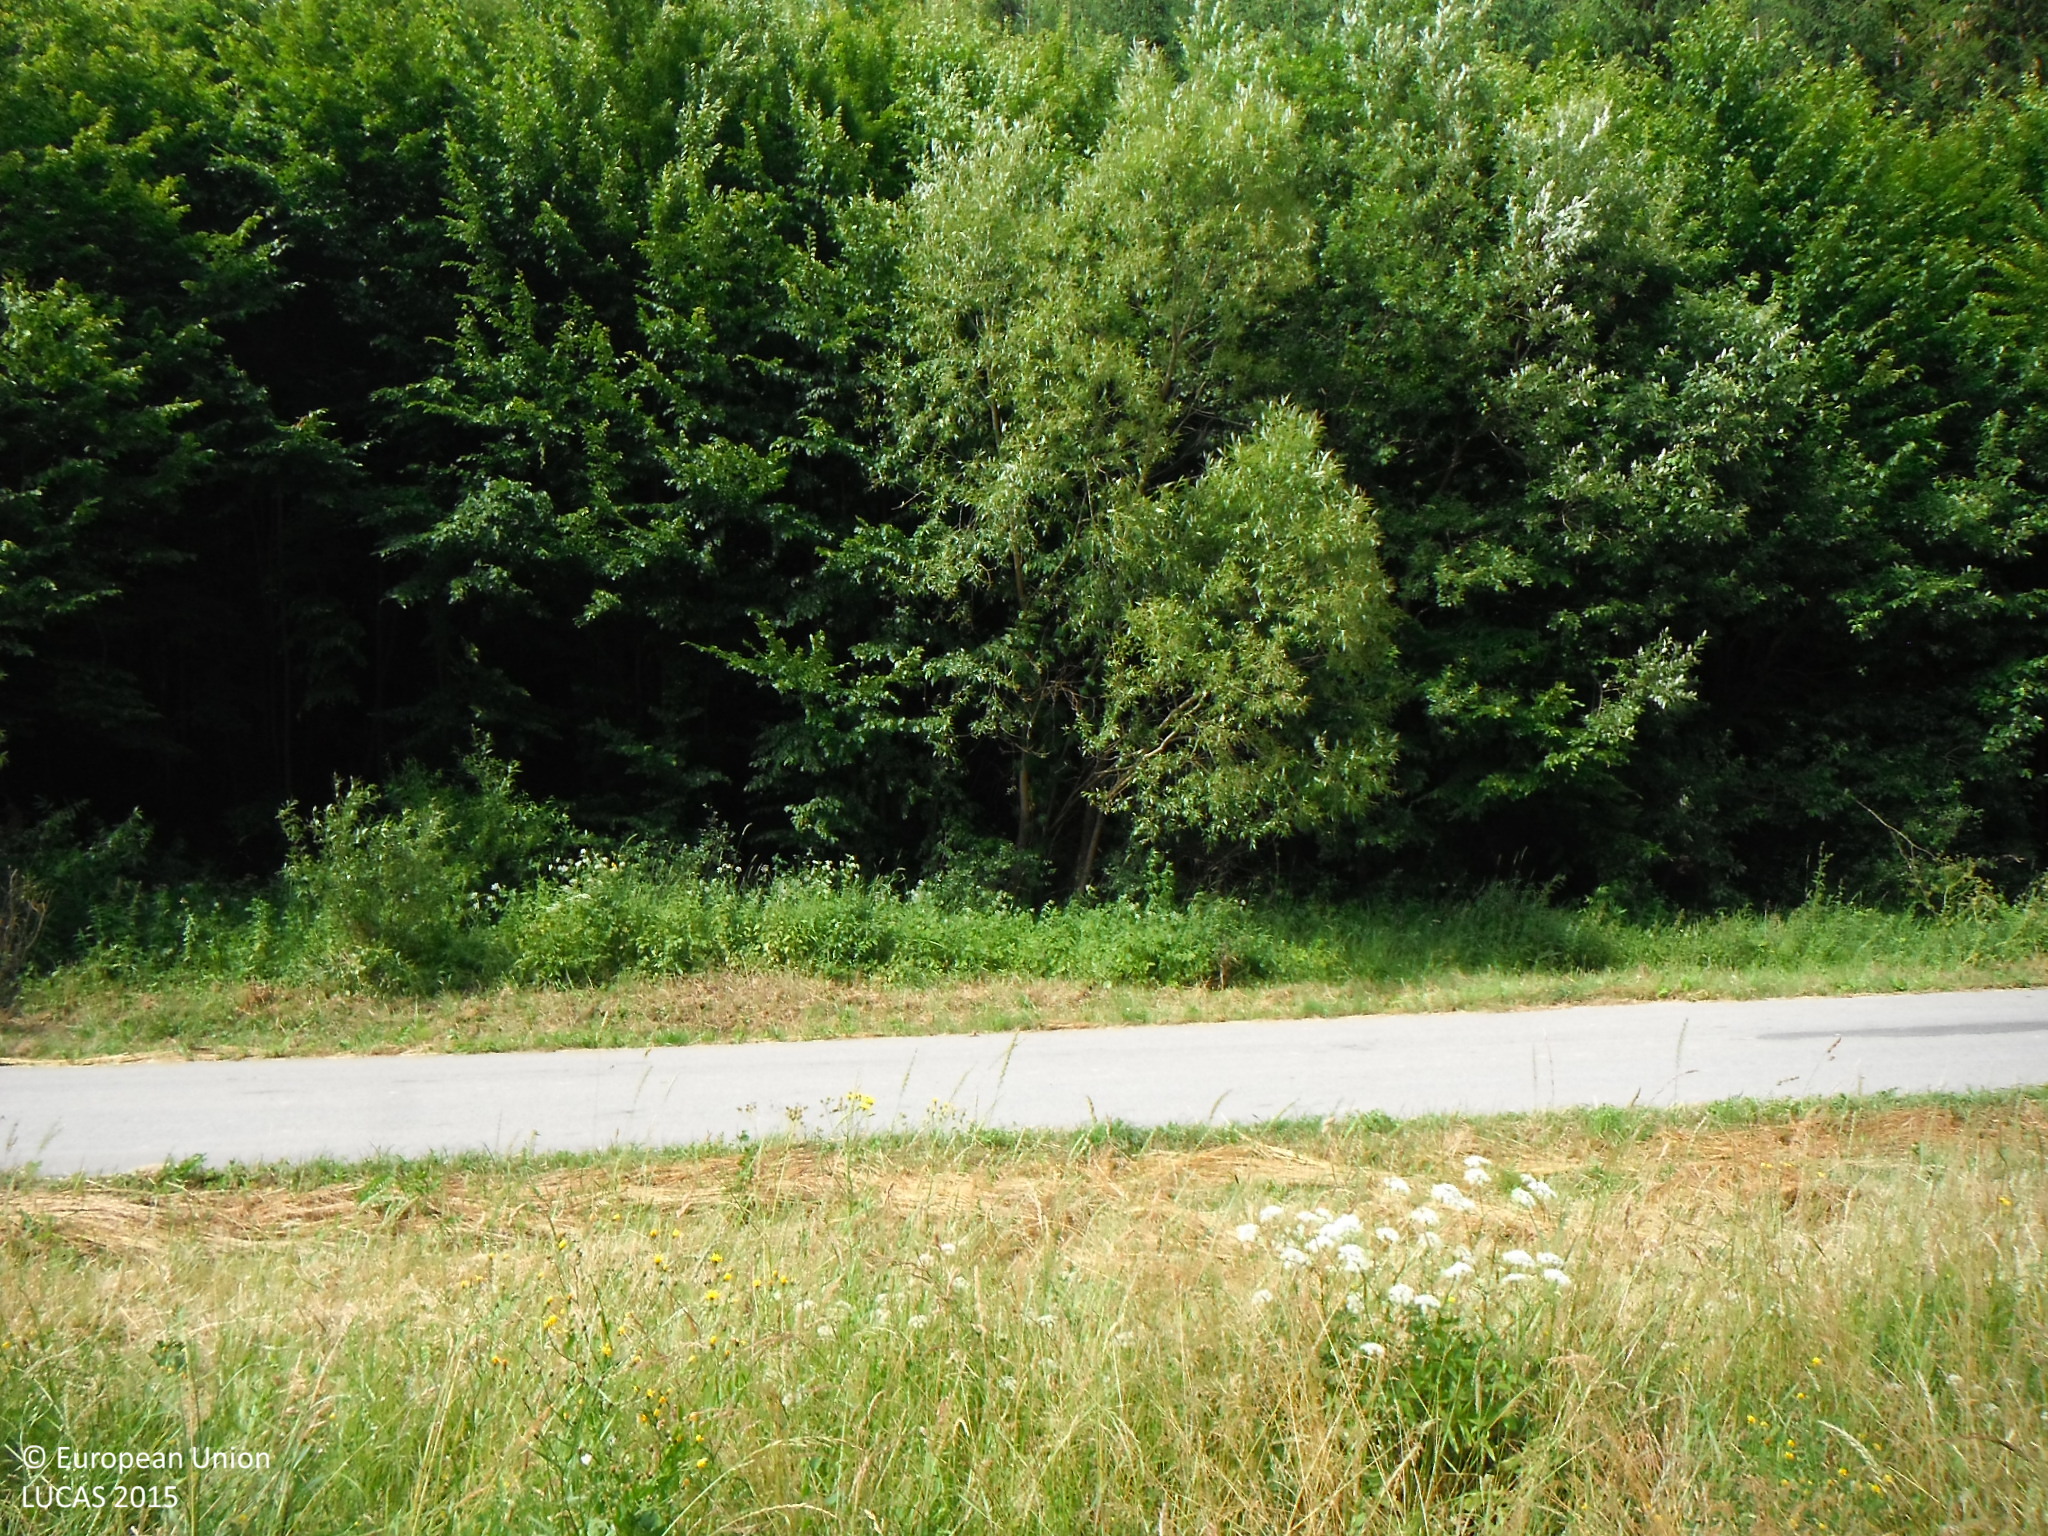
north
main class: Grassland
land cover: Grassland without tree/shrub cover
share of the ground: > 75 %
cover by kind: herbaceous plants 100 %
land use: Agriculture (excluding fallow land and kitchen gardens)
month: June
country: SK
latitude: 49.3478
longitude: 21.6554
